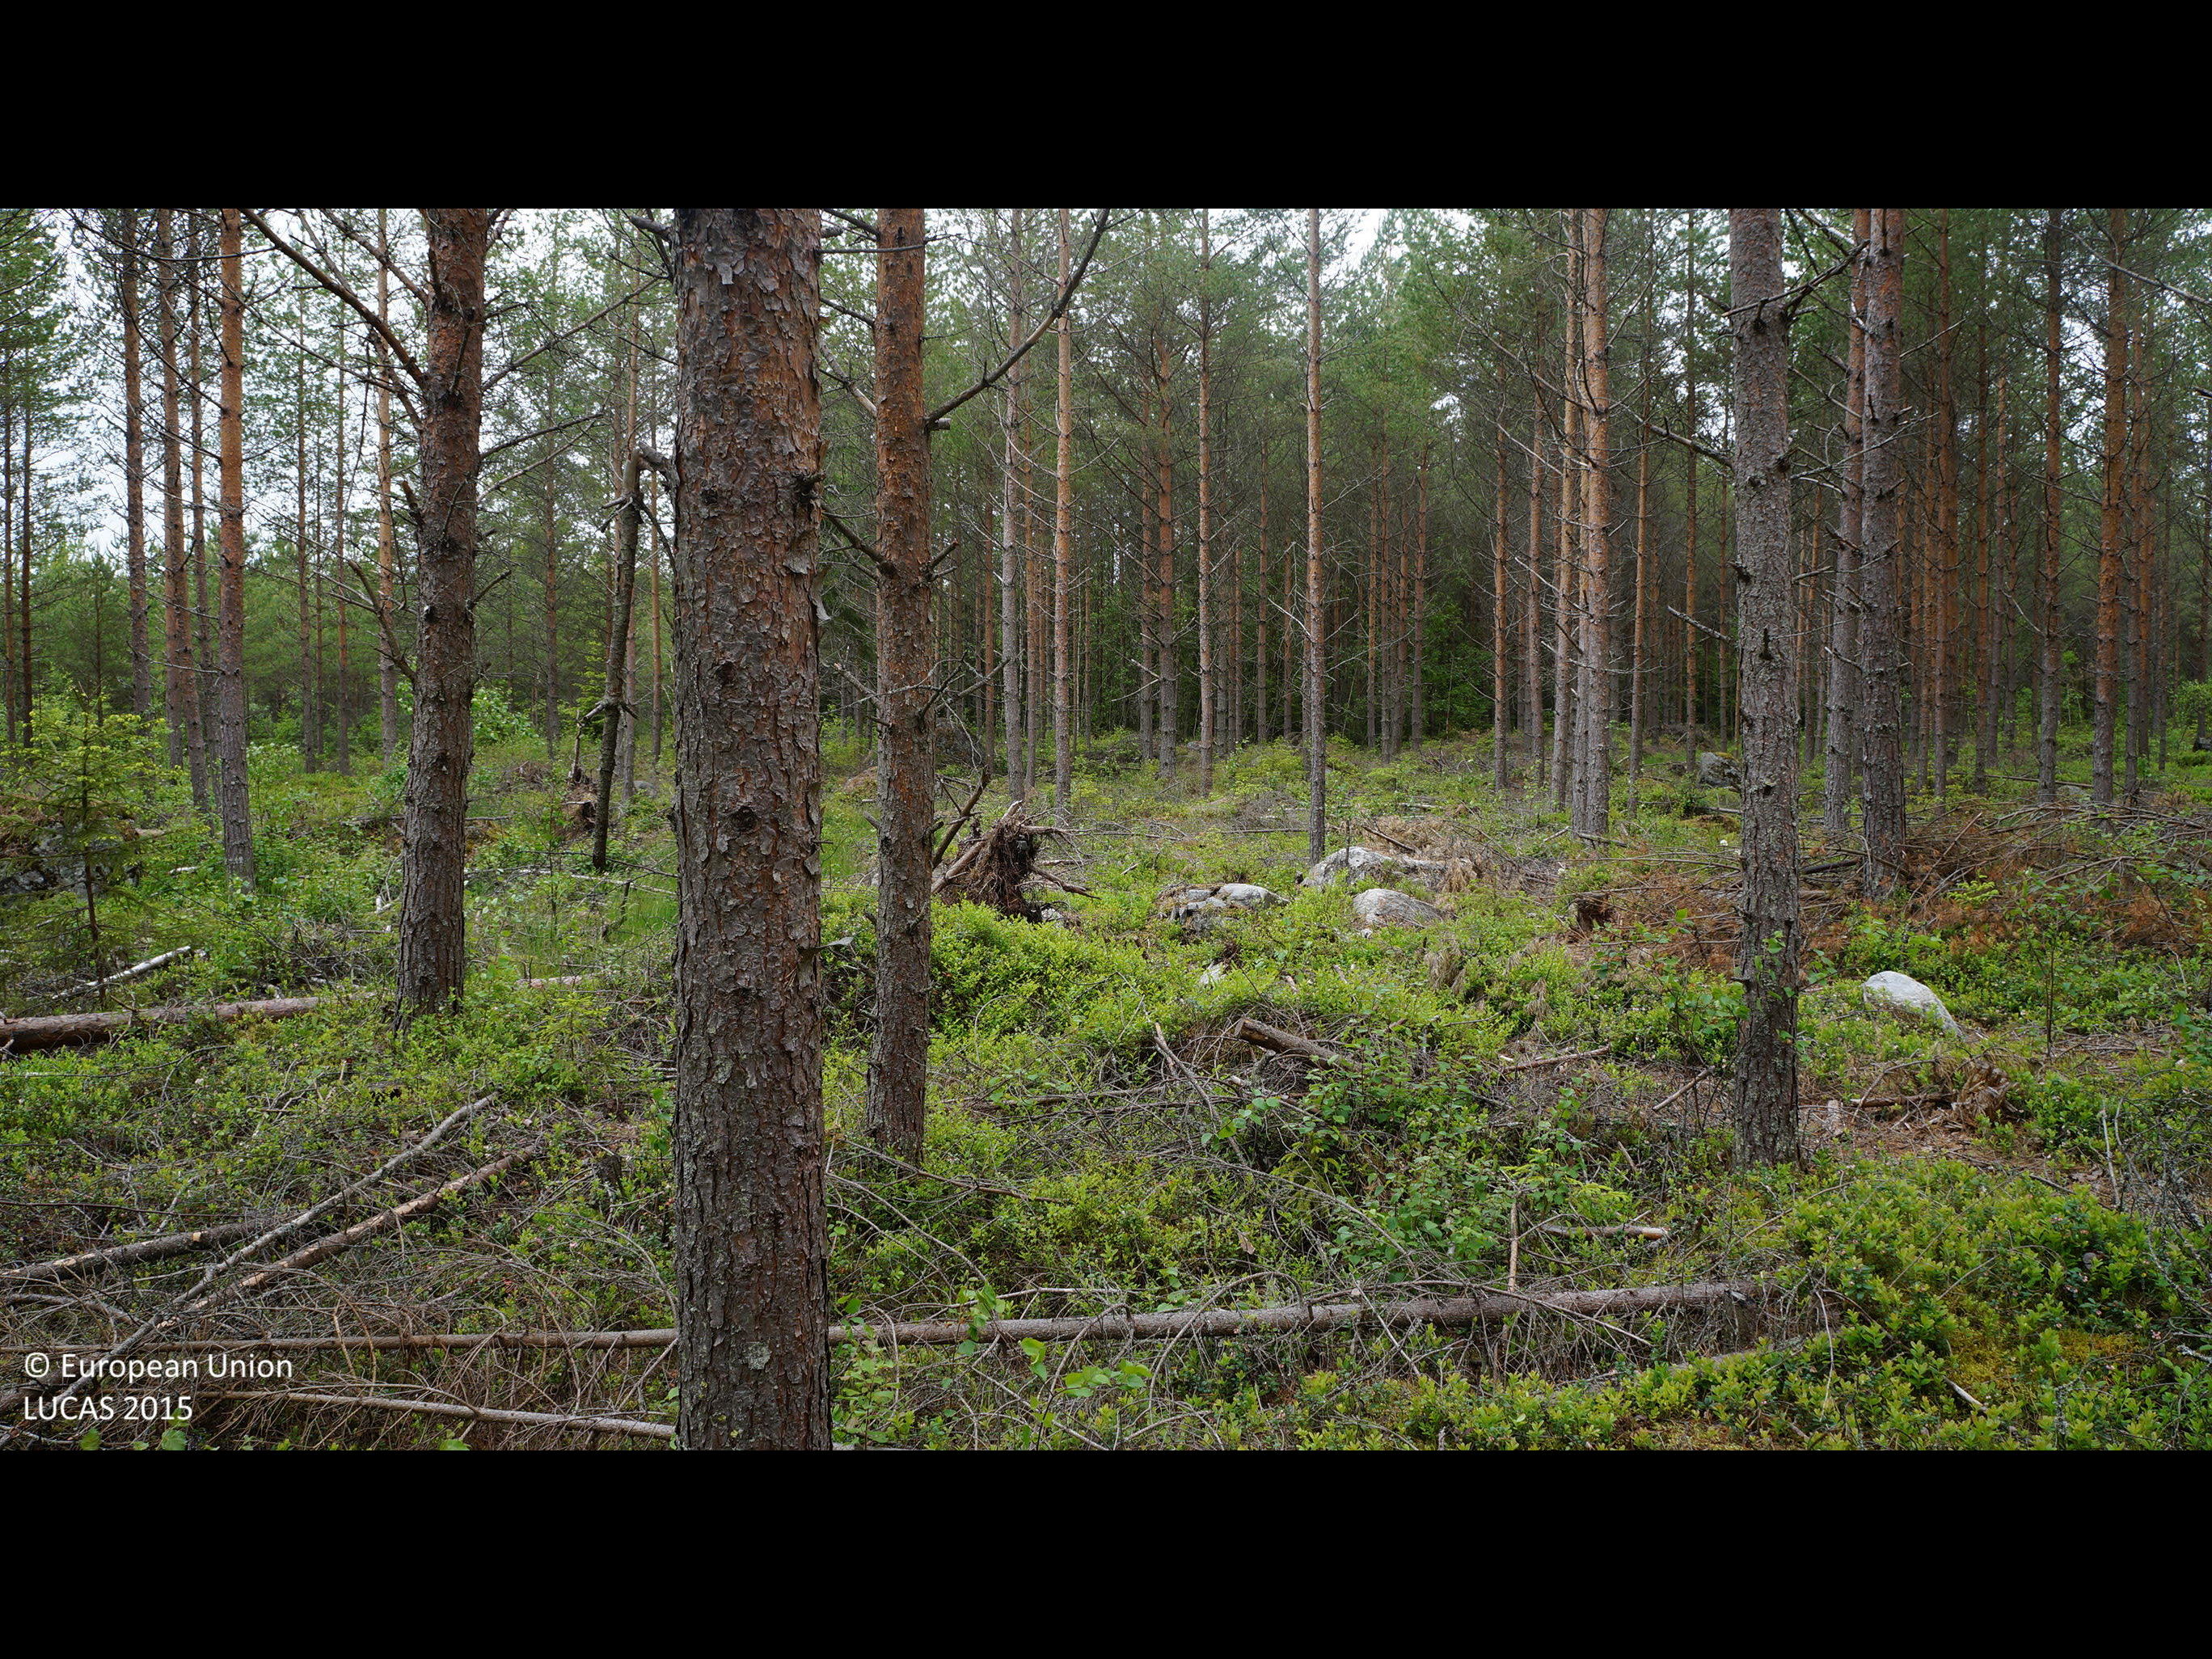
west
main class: Woodland
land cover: Pine dominated coniferous woodland
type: boreal forest
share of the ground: 50 - 75 %
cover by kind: coniferous forest trees 60 %, shrubs 20 %, lichens and mosses 15 %, consolidated bare surface 5 %
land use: Forestry
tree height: > 5 m
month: June
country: FI
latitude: 63.8995
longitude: 23.1937
